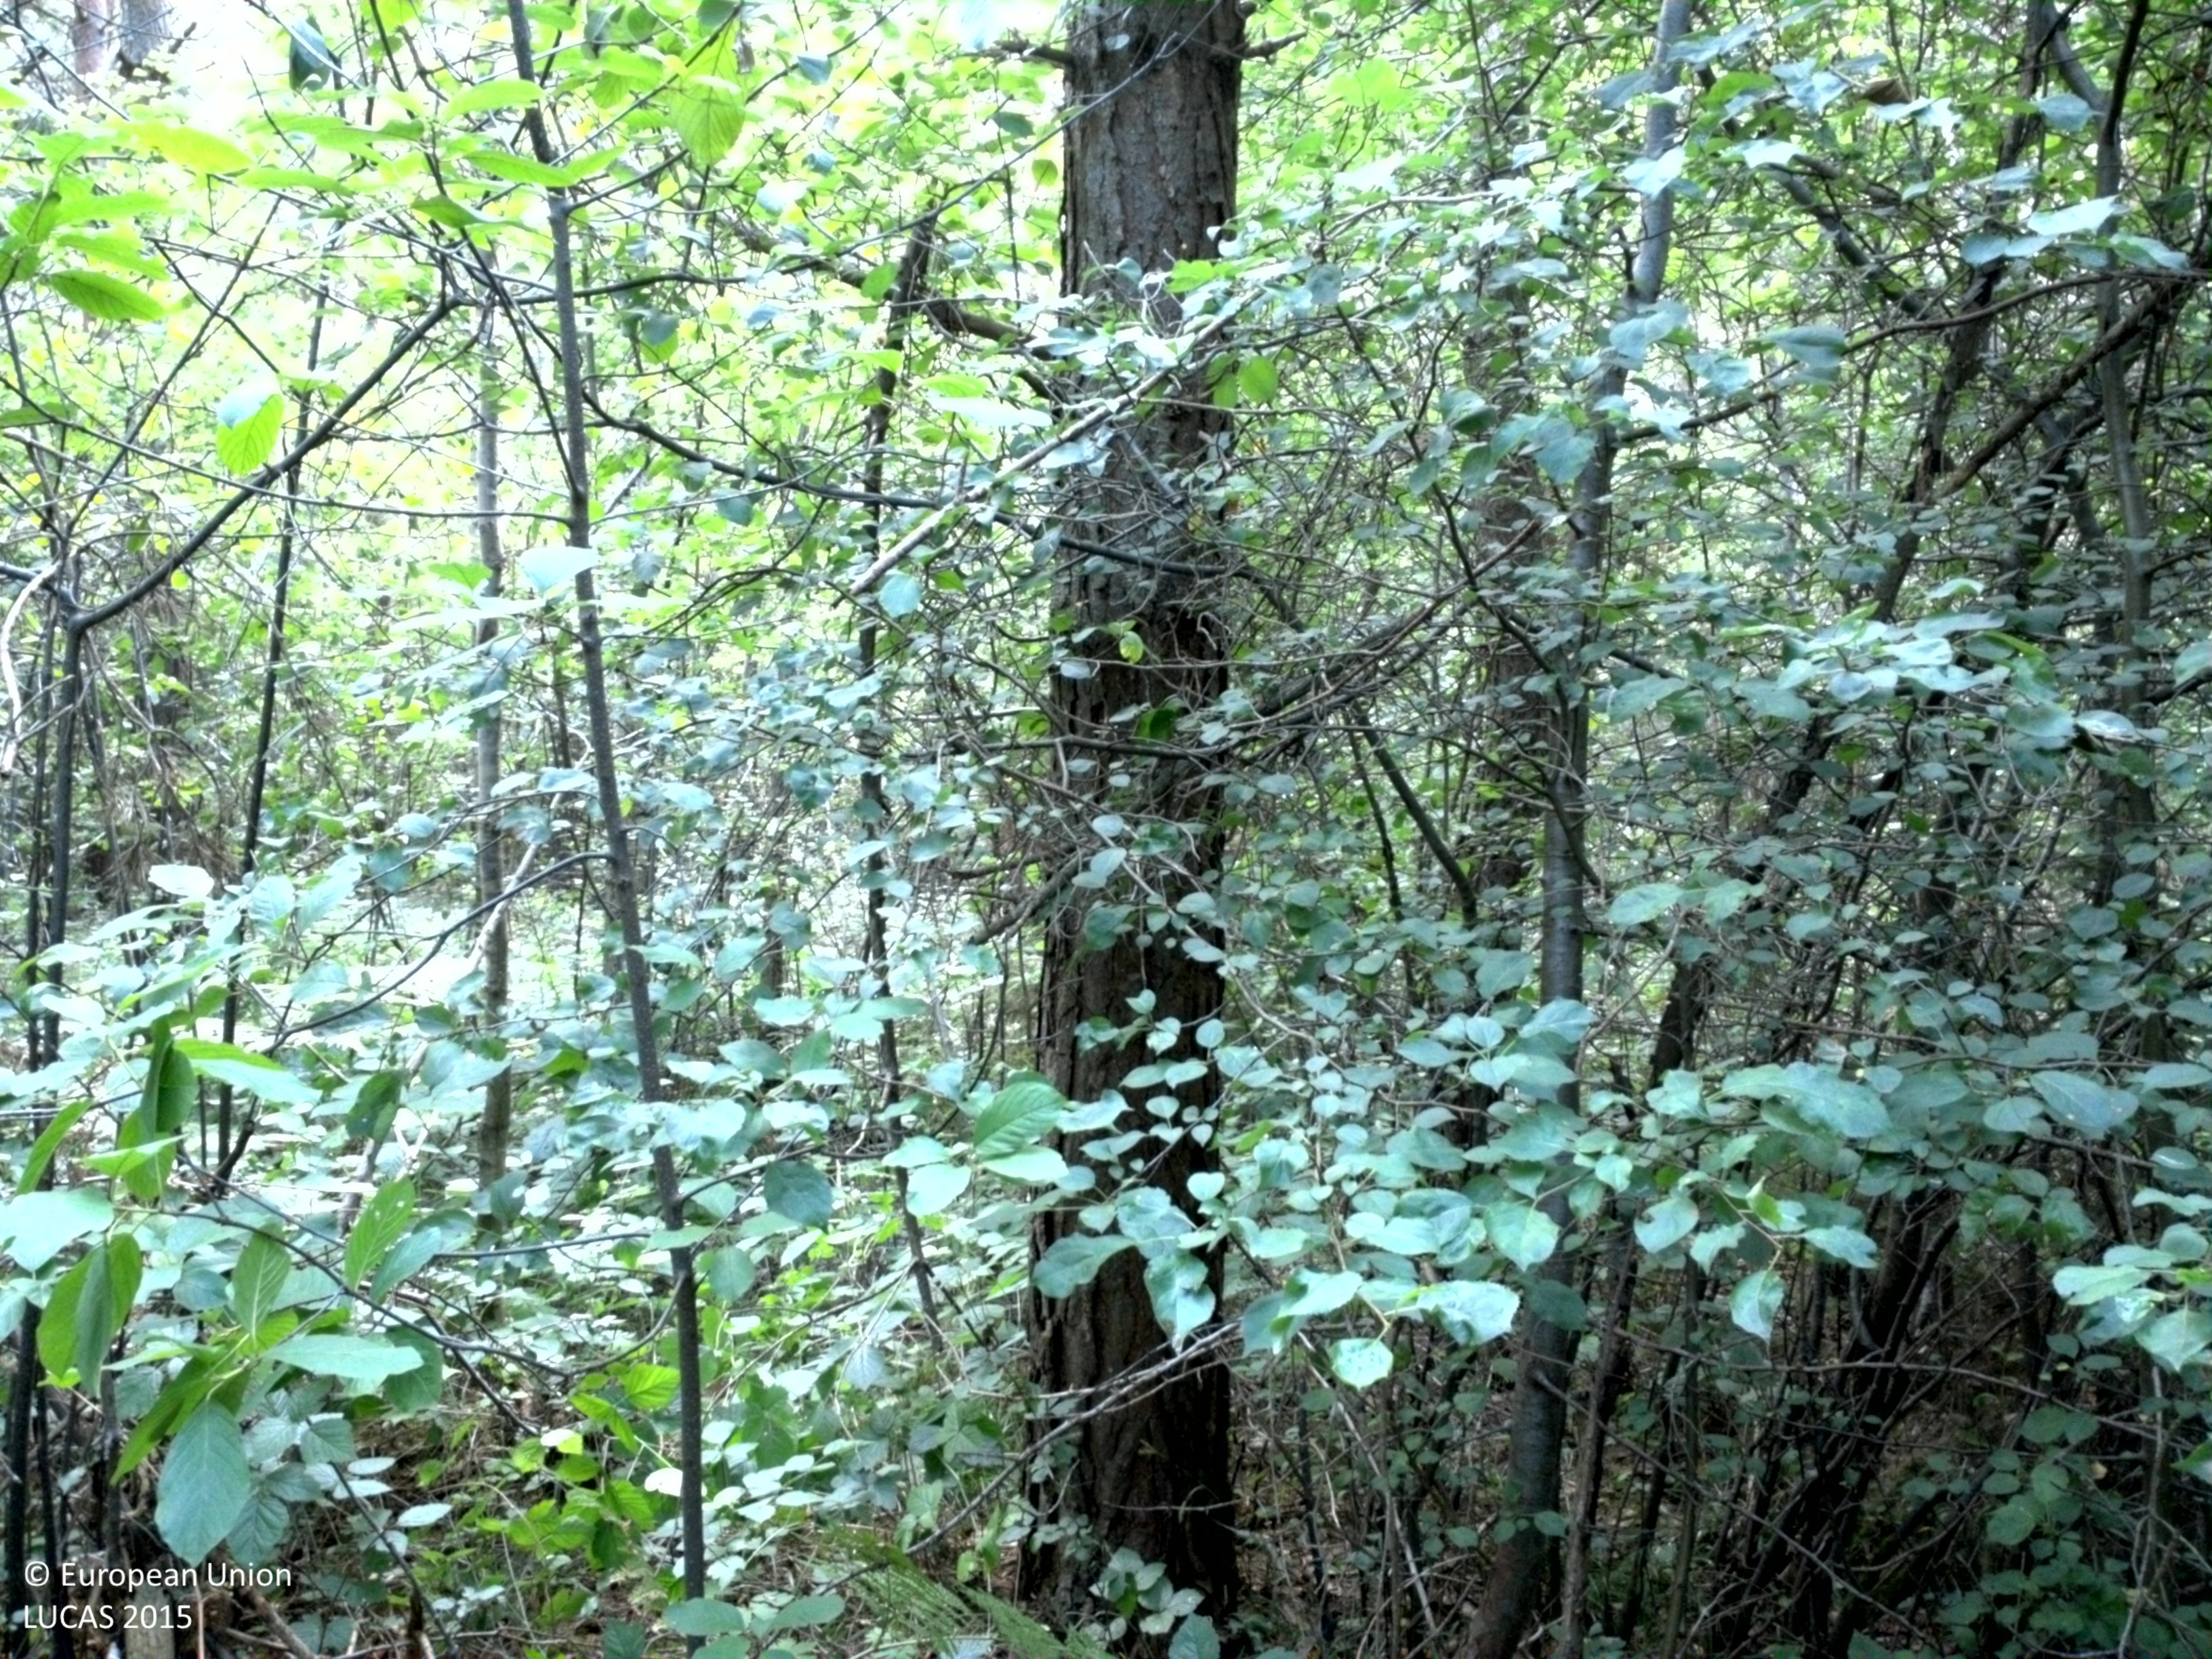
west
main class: Woodland
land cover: Pine dominated mixed woodland
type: hemiboreal forest and nemoral coniferous forest and mixed broadleaved-coniferous forest
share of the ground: > 75 %
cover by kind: coniferous forest trees 60 %, broadleaved forest trees 20 %, herbaceous plants 15 %, shrubs 5 %
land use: Forestry
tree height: > 5 m
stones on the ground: < 10 %
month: July
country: SE
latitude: 57.5458
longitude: 18.3112
